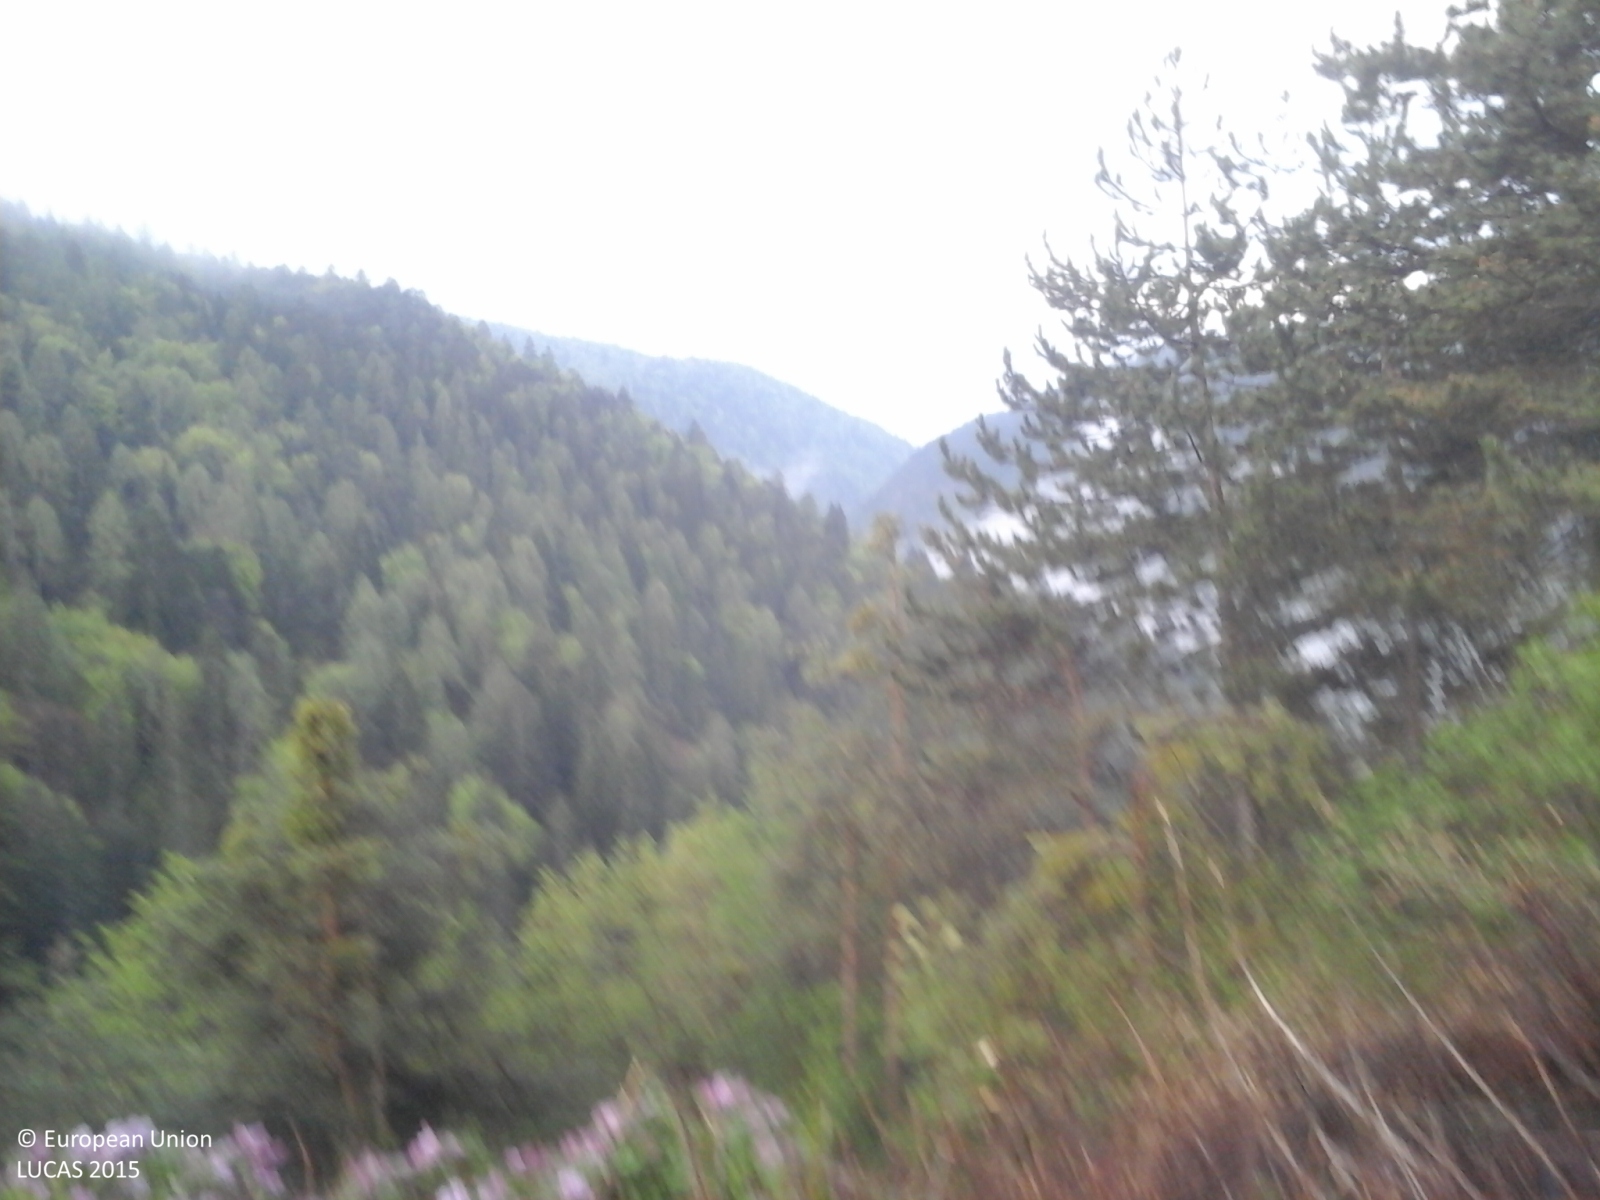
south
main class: Woodland
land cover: Spruce dominated mixed woodland
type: alpine coniferous forest
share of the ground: > 75 %
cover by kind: coniferous forest trees 50 %, broadleaved forest trees 50 %
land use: Forestry
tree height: > 5 m
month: May
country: IT
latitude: 46.3813
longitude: 11.1297
